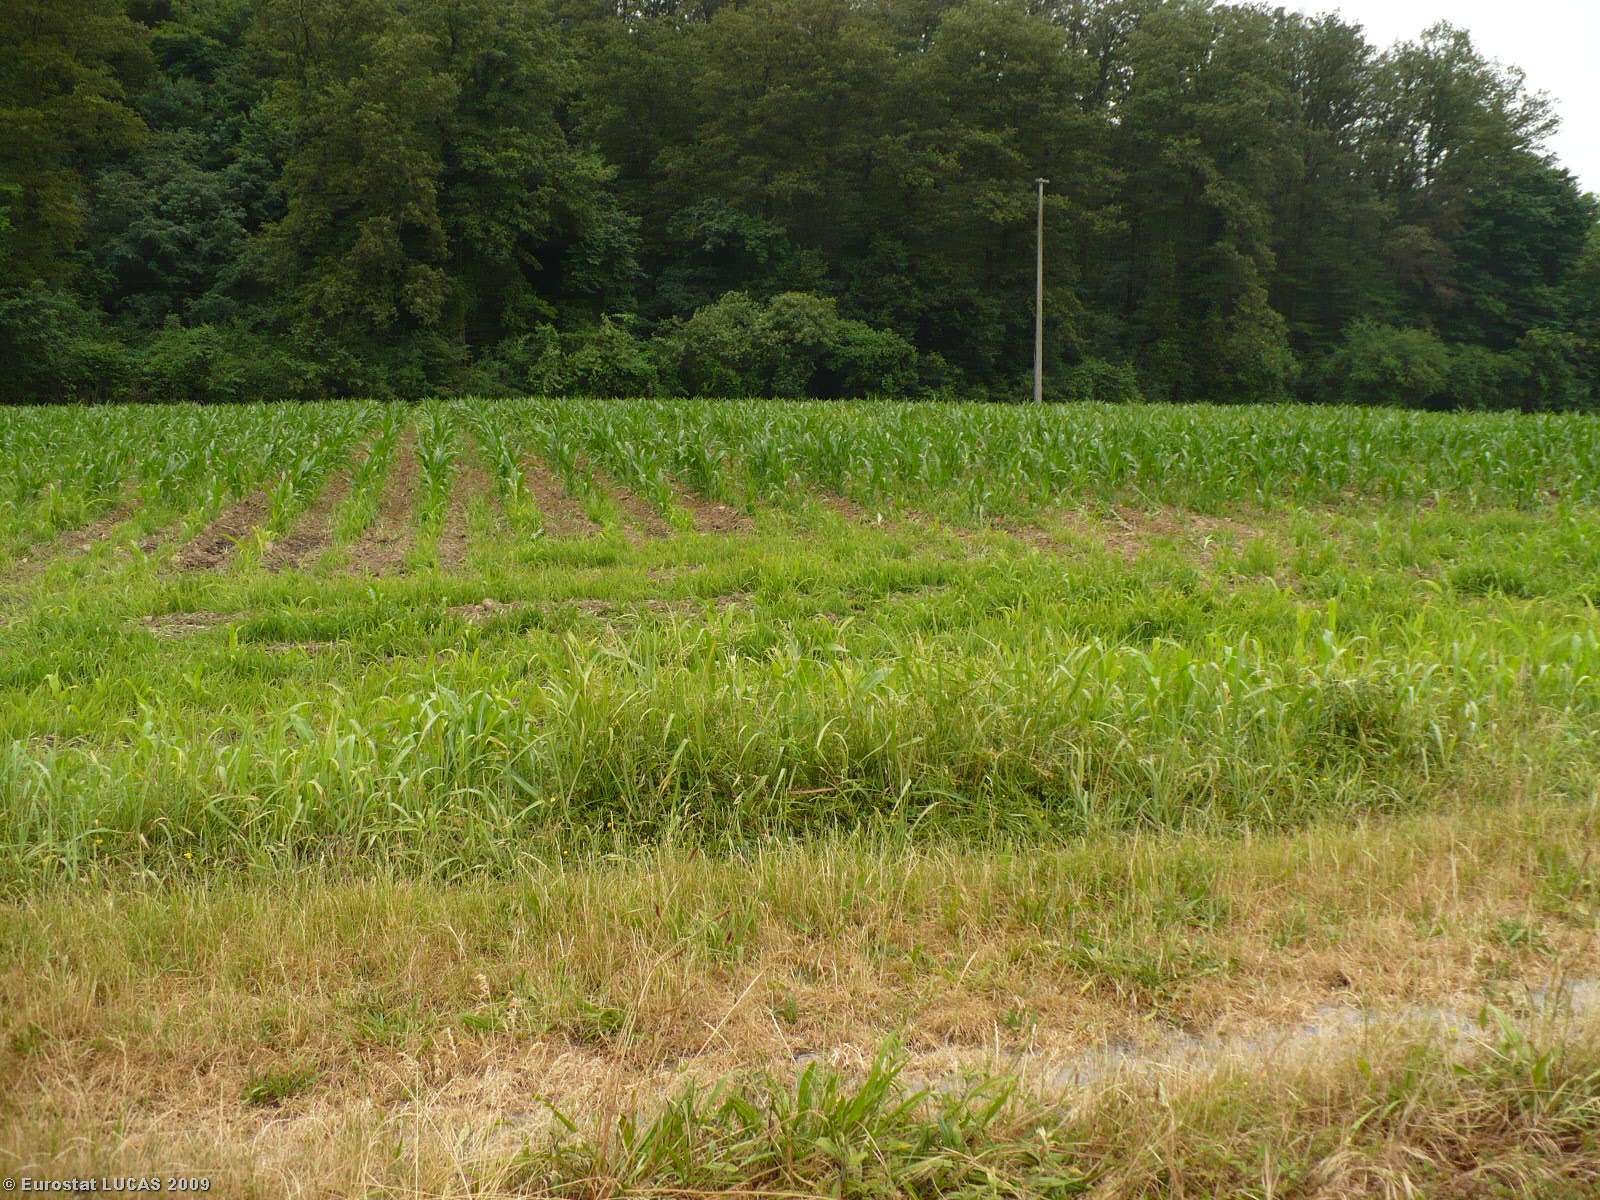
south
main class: Cropland
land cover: Maize
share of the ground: 50 - 75 %
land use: Agriculture (excluding fallow land and kitchen gardens)
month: June
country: IT
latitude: 45.3934
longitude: 10.7778
